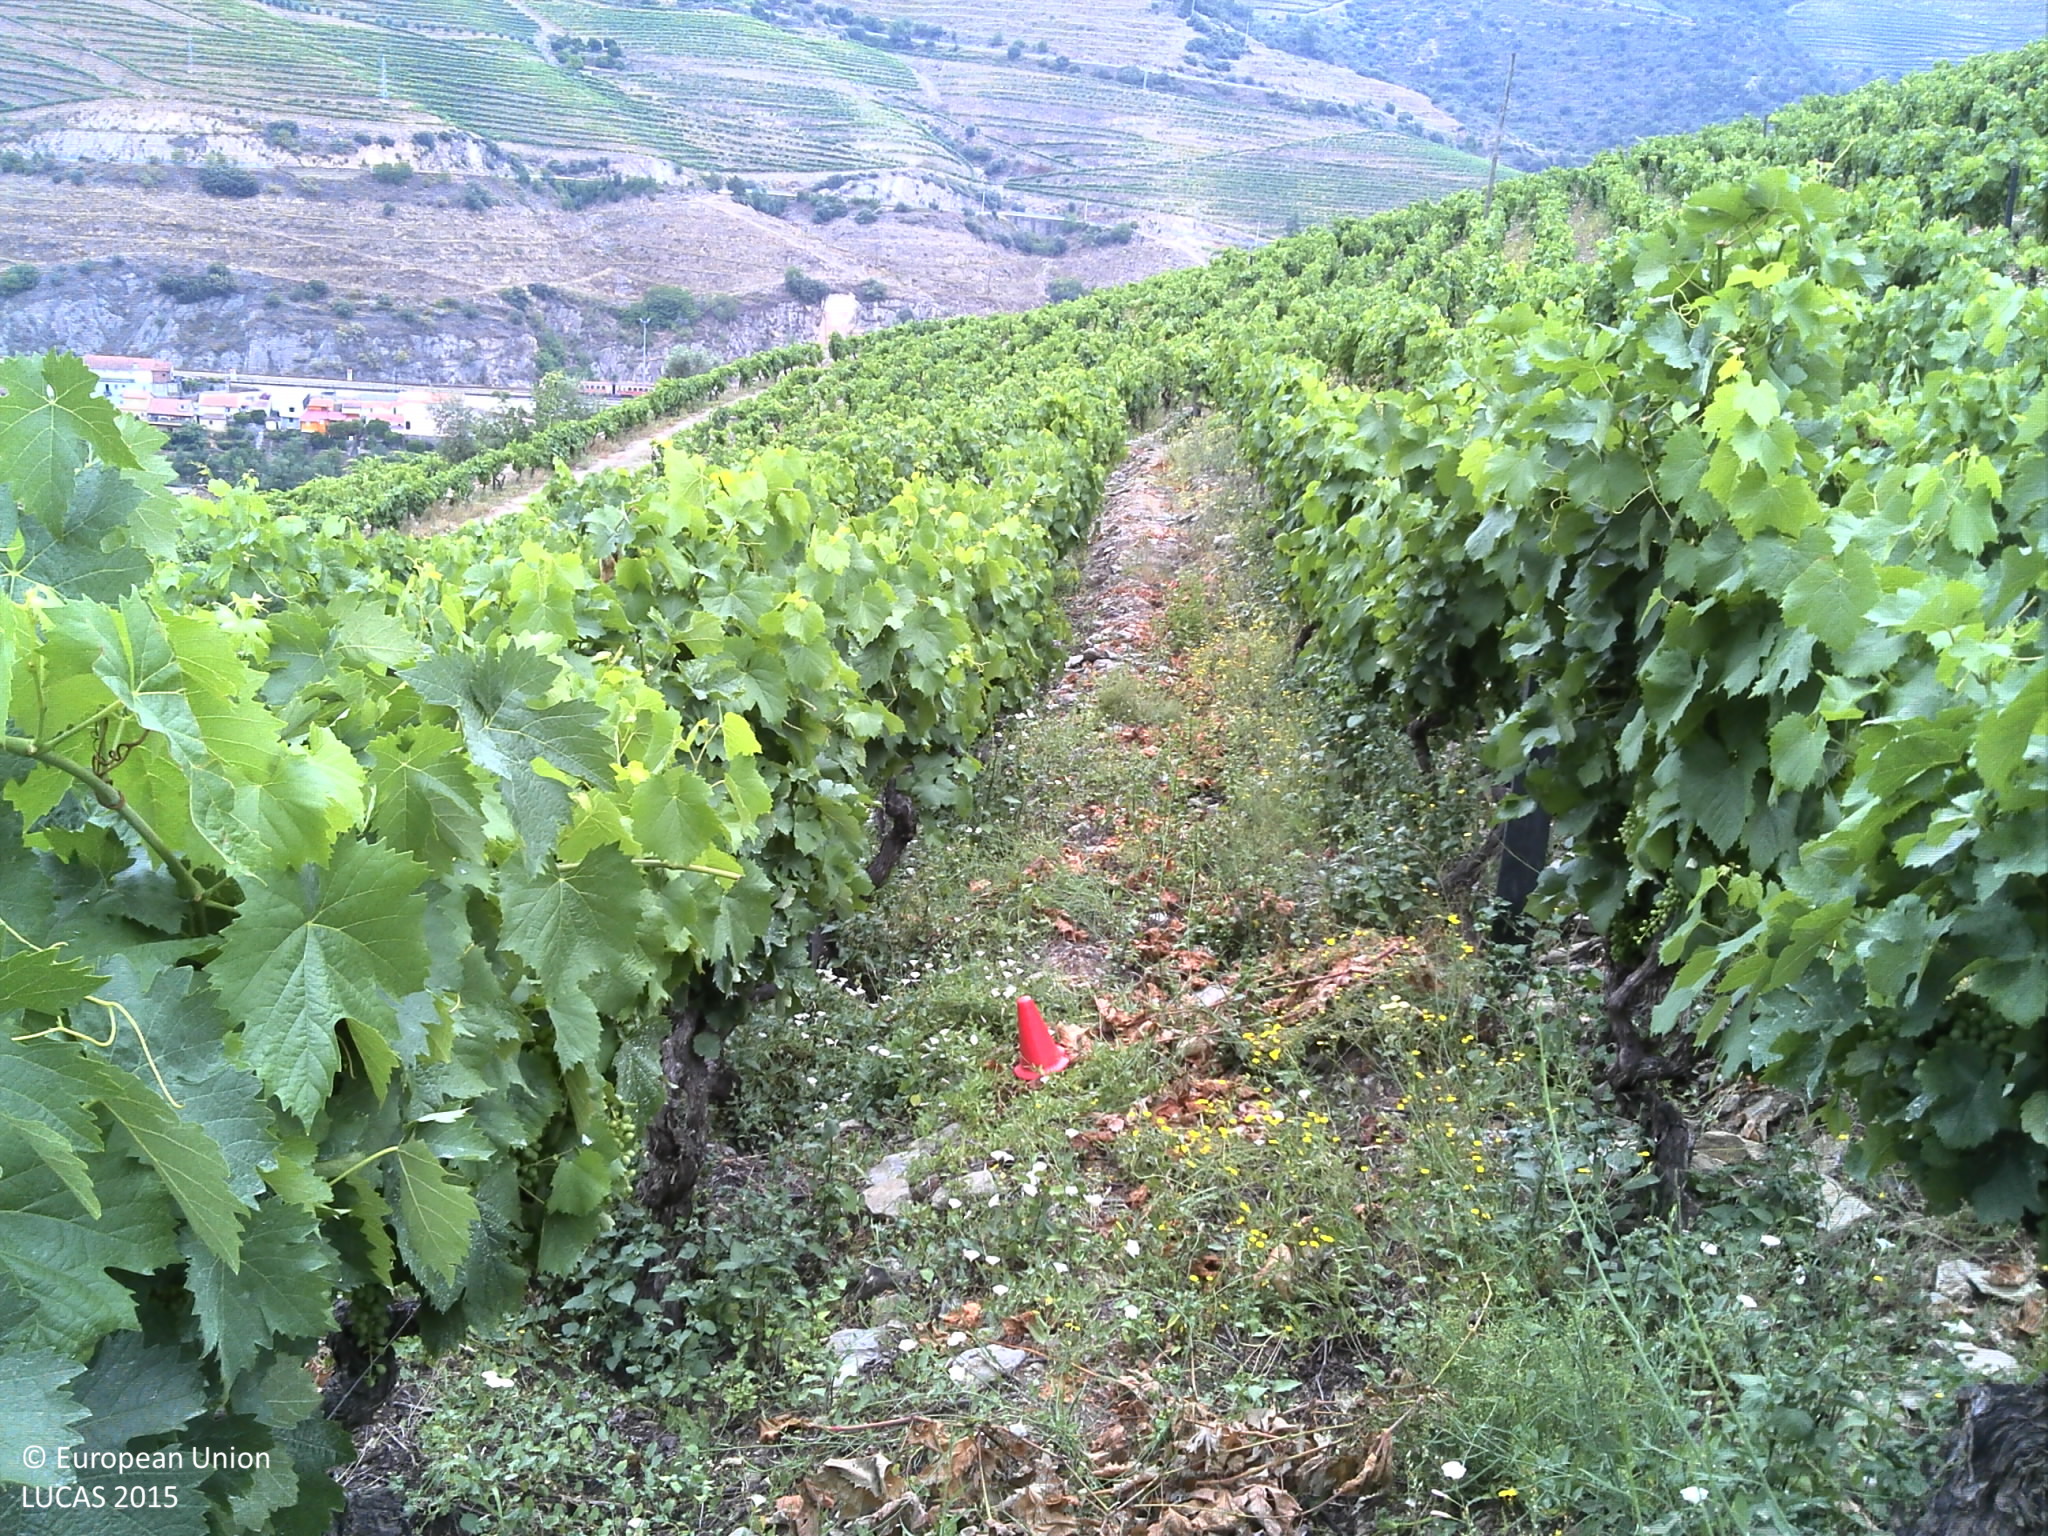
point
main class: Cropland
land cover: Vineyards
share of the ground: 10 - 25 %
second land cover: Spontaneously vegetated surfaces
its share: 50 - 75 %
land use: Agriculture (excluding fallow land and kitchen gardens)
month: June
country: PT
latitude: 41.2037
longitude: -7.4242
